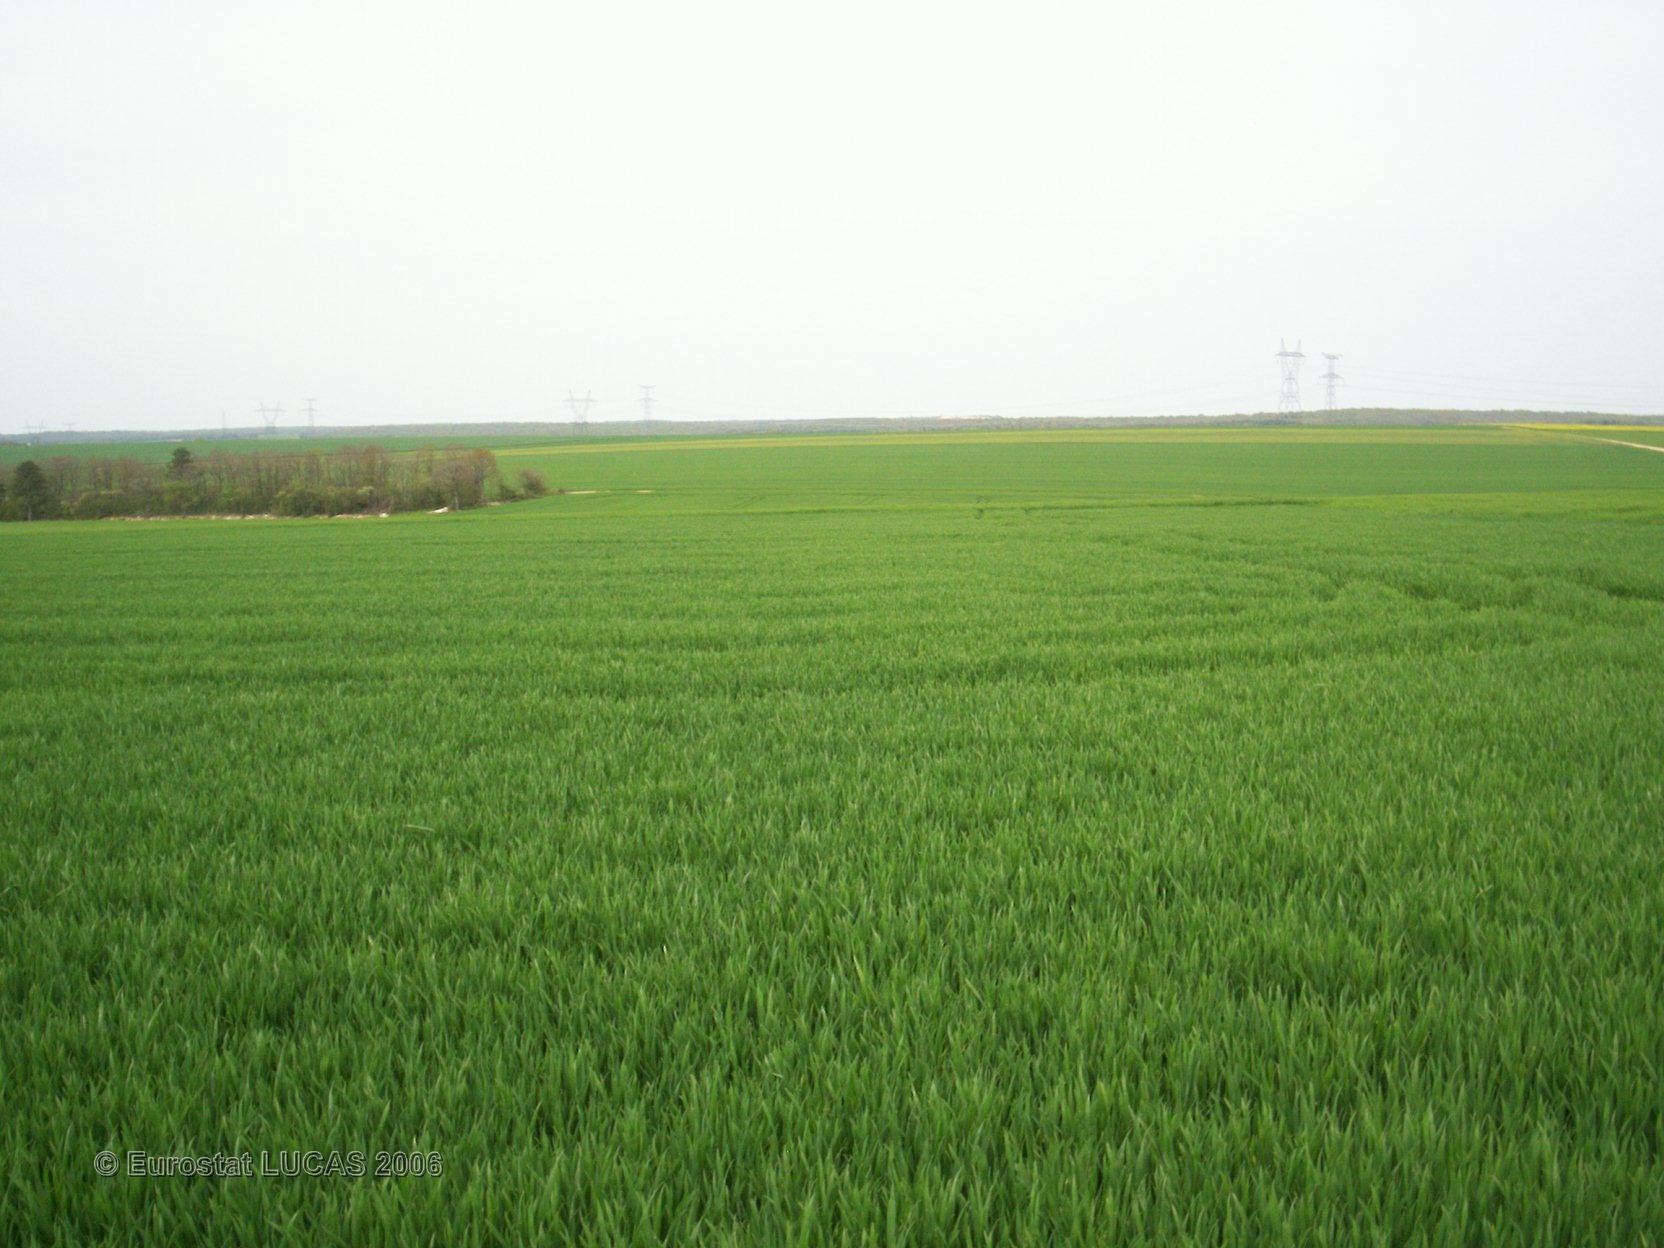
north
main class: Cropland
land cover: Common wheat
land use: Agriculture (excluding fallow land and kitchen gardens)
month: May
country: FR
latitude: 47.6368
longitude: 4.5286
